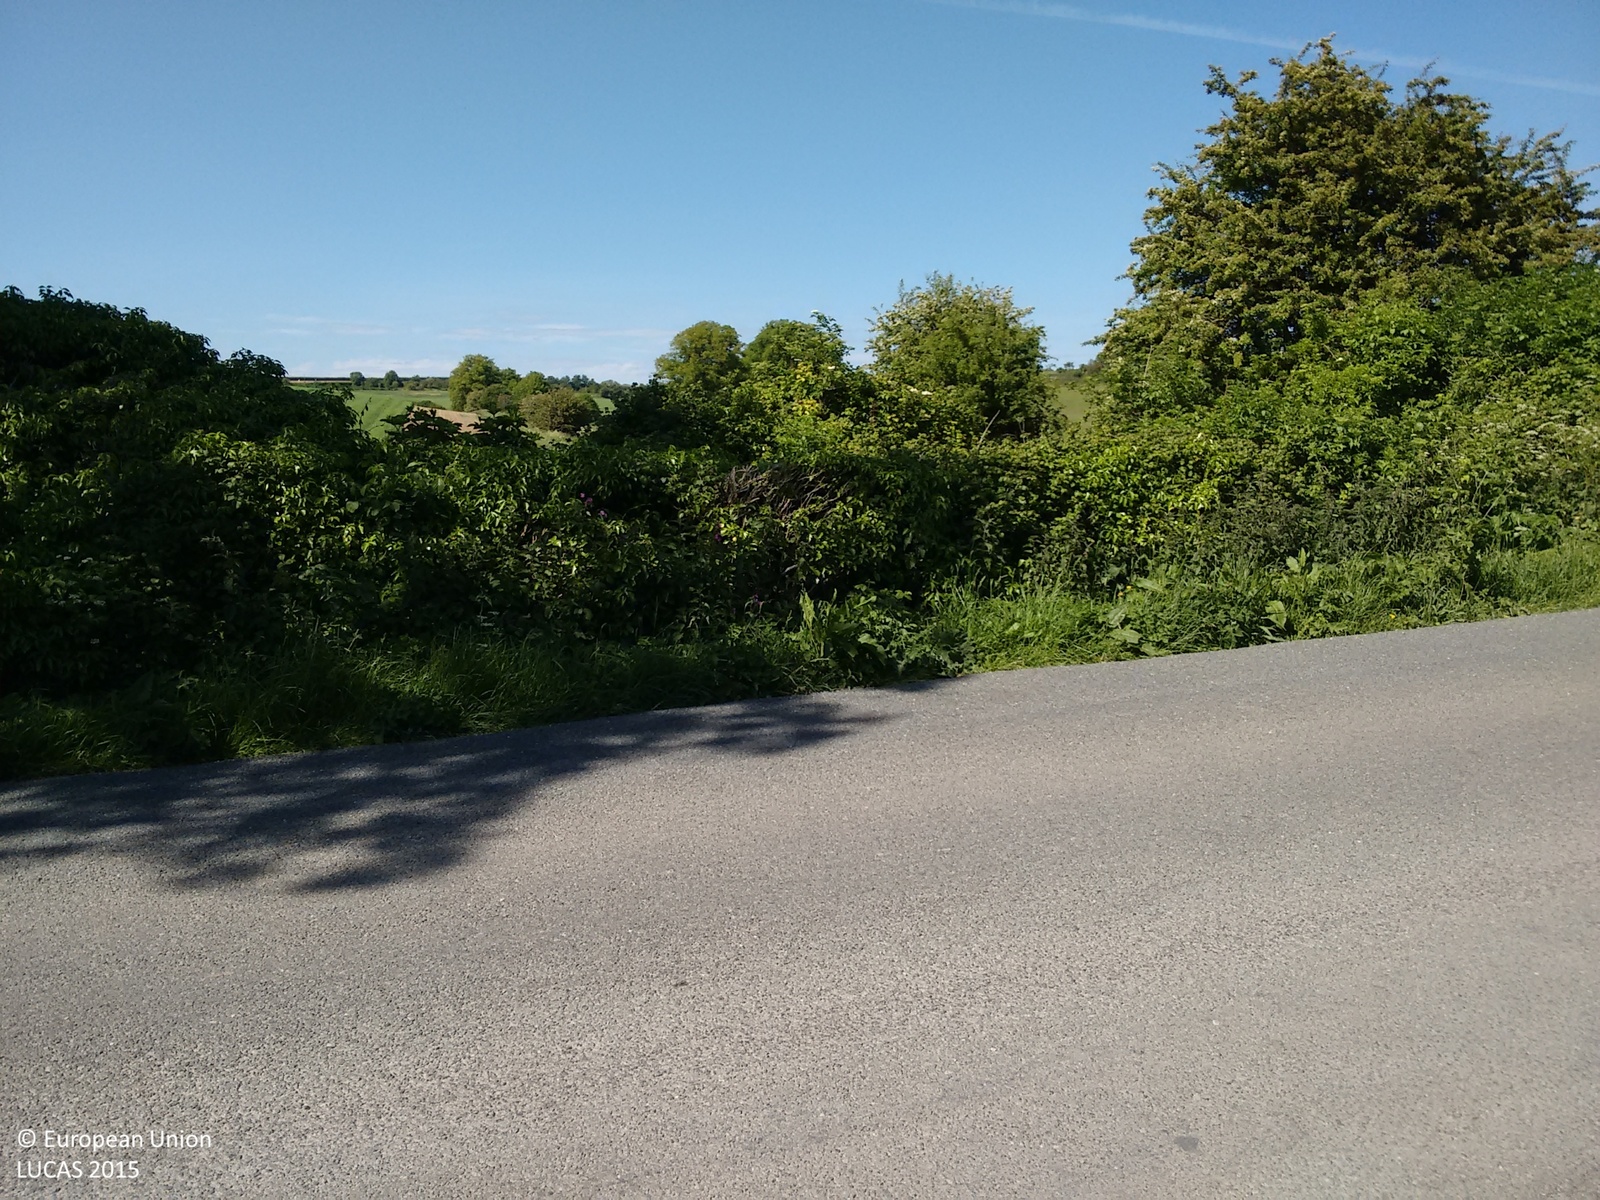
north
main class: Grassland
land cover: Spontaneously vegetated surfaces
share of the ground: > 75 %
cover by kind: herbaceous plants 95 %, shrubs 5 %
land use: Abandoned areas
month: June
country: GB
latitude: 50.7231
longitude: -2.4025
